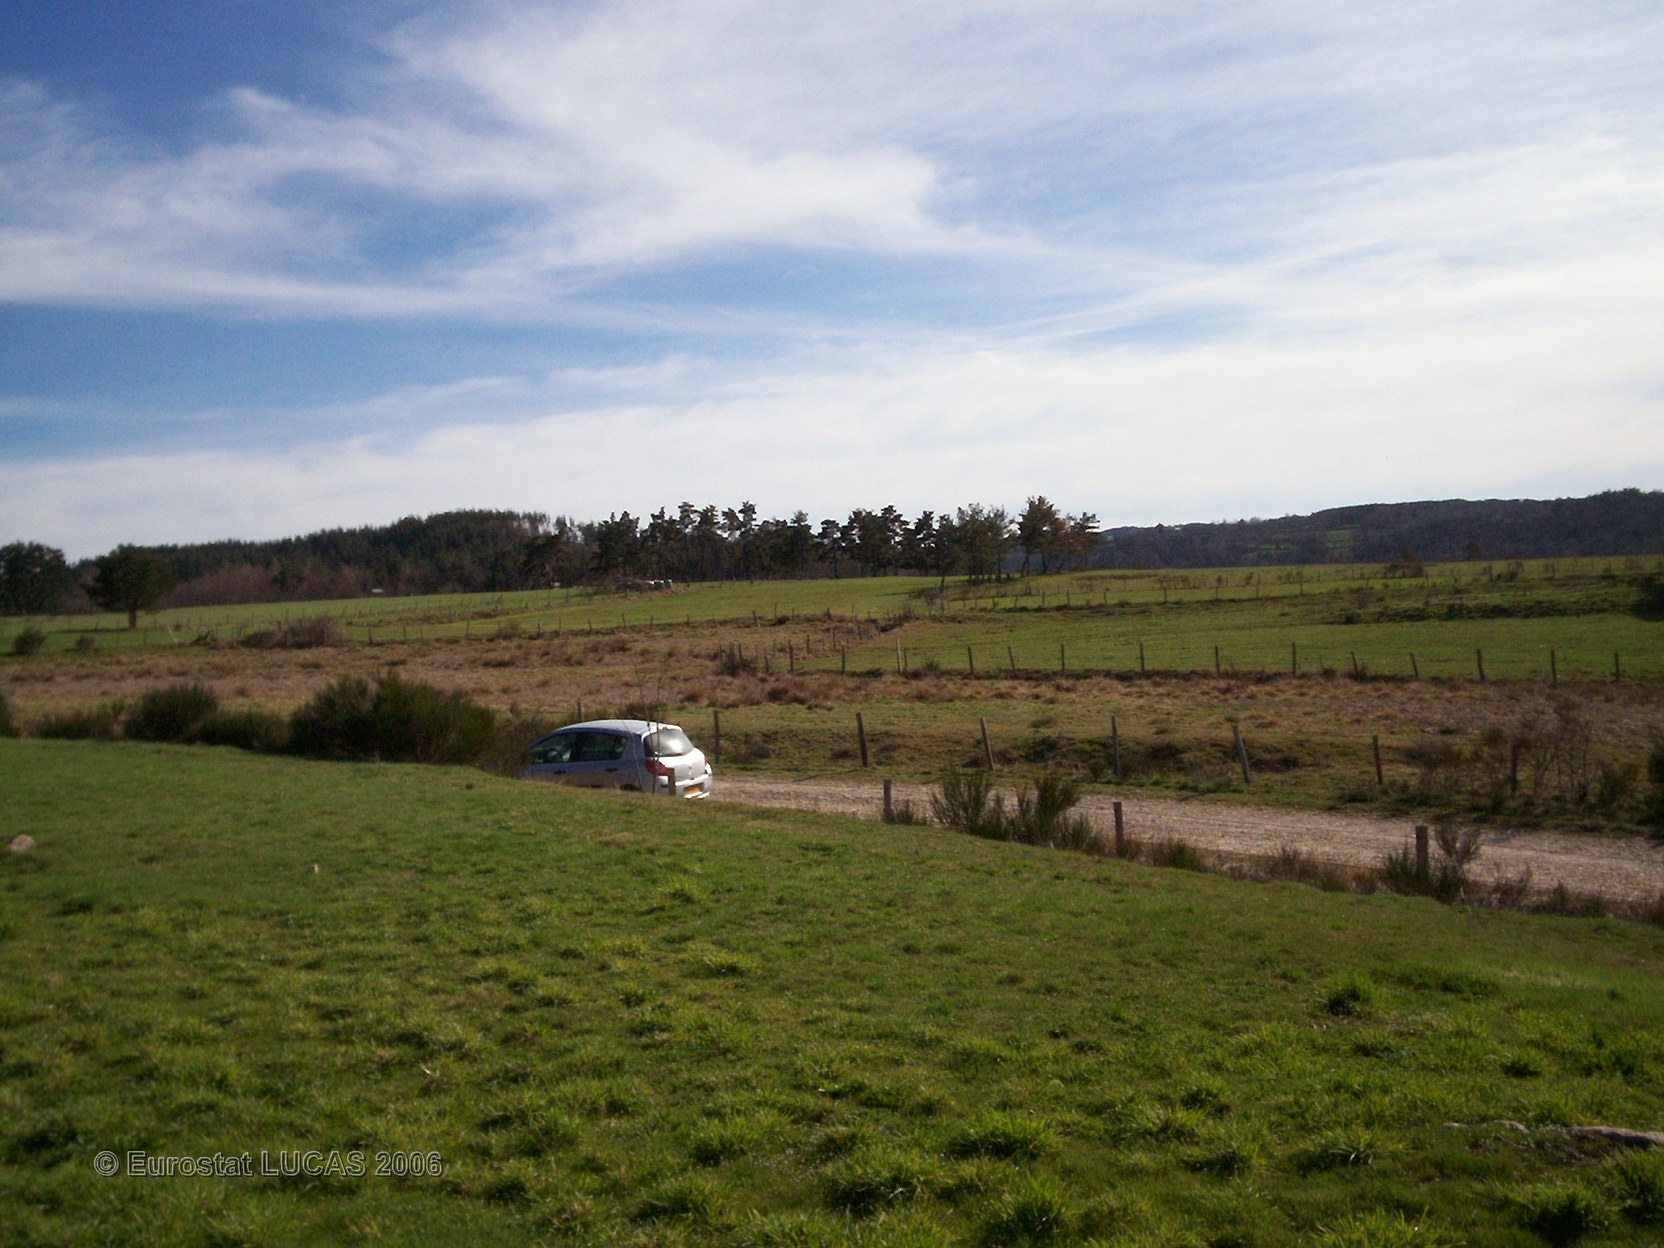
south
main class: Grassland
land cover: Grassland without tree/shrub cover
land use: Agriculture (excluding fallow land and kitchen gardens)
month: April
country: FR
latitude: 44.8434
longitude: 3.3617
